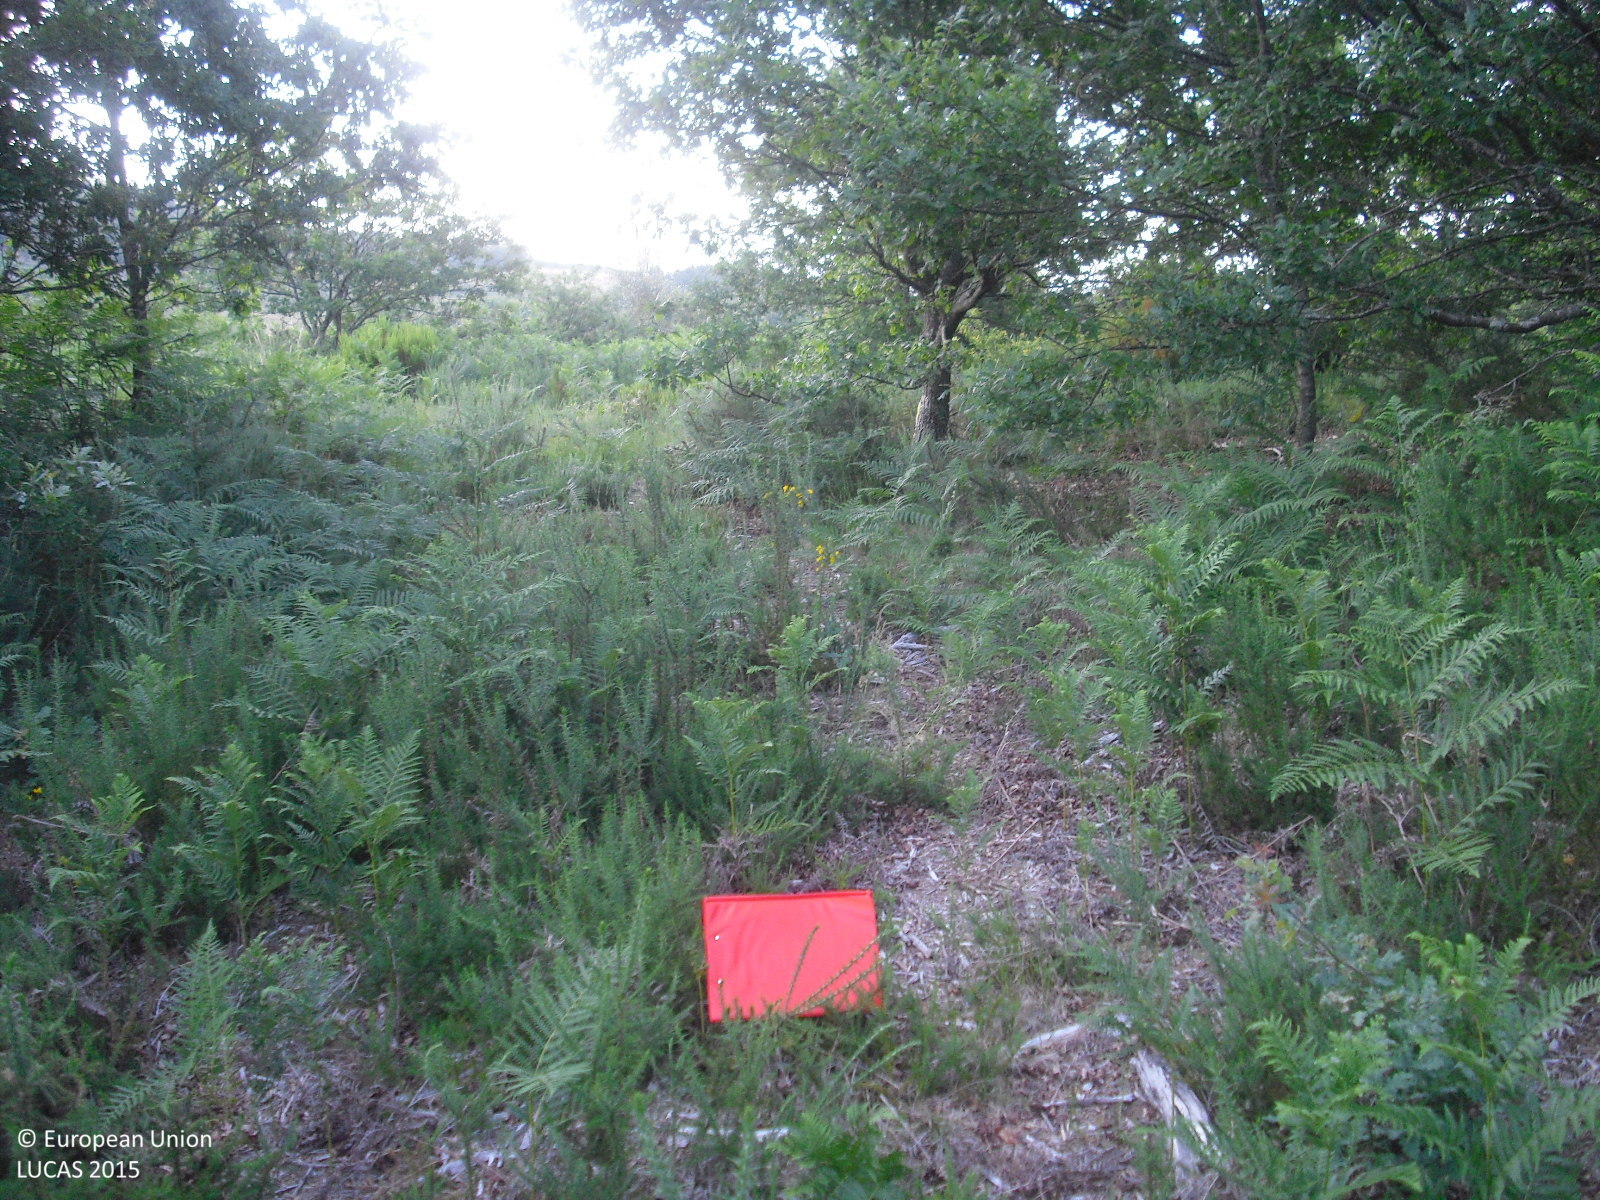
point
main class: Woodland
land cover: Broadleaved woodland
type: thermophilous deciduous forest
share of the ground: 50 - 75 %
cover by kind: broadleaved forest trees 60 %, shrubs 30 %, herbaceous plants 10 %
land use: Forestry
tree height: > 5 m
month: June
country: ES
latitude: 42.5571
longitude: -7.8999
